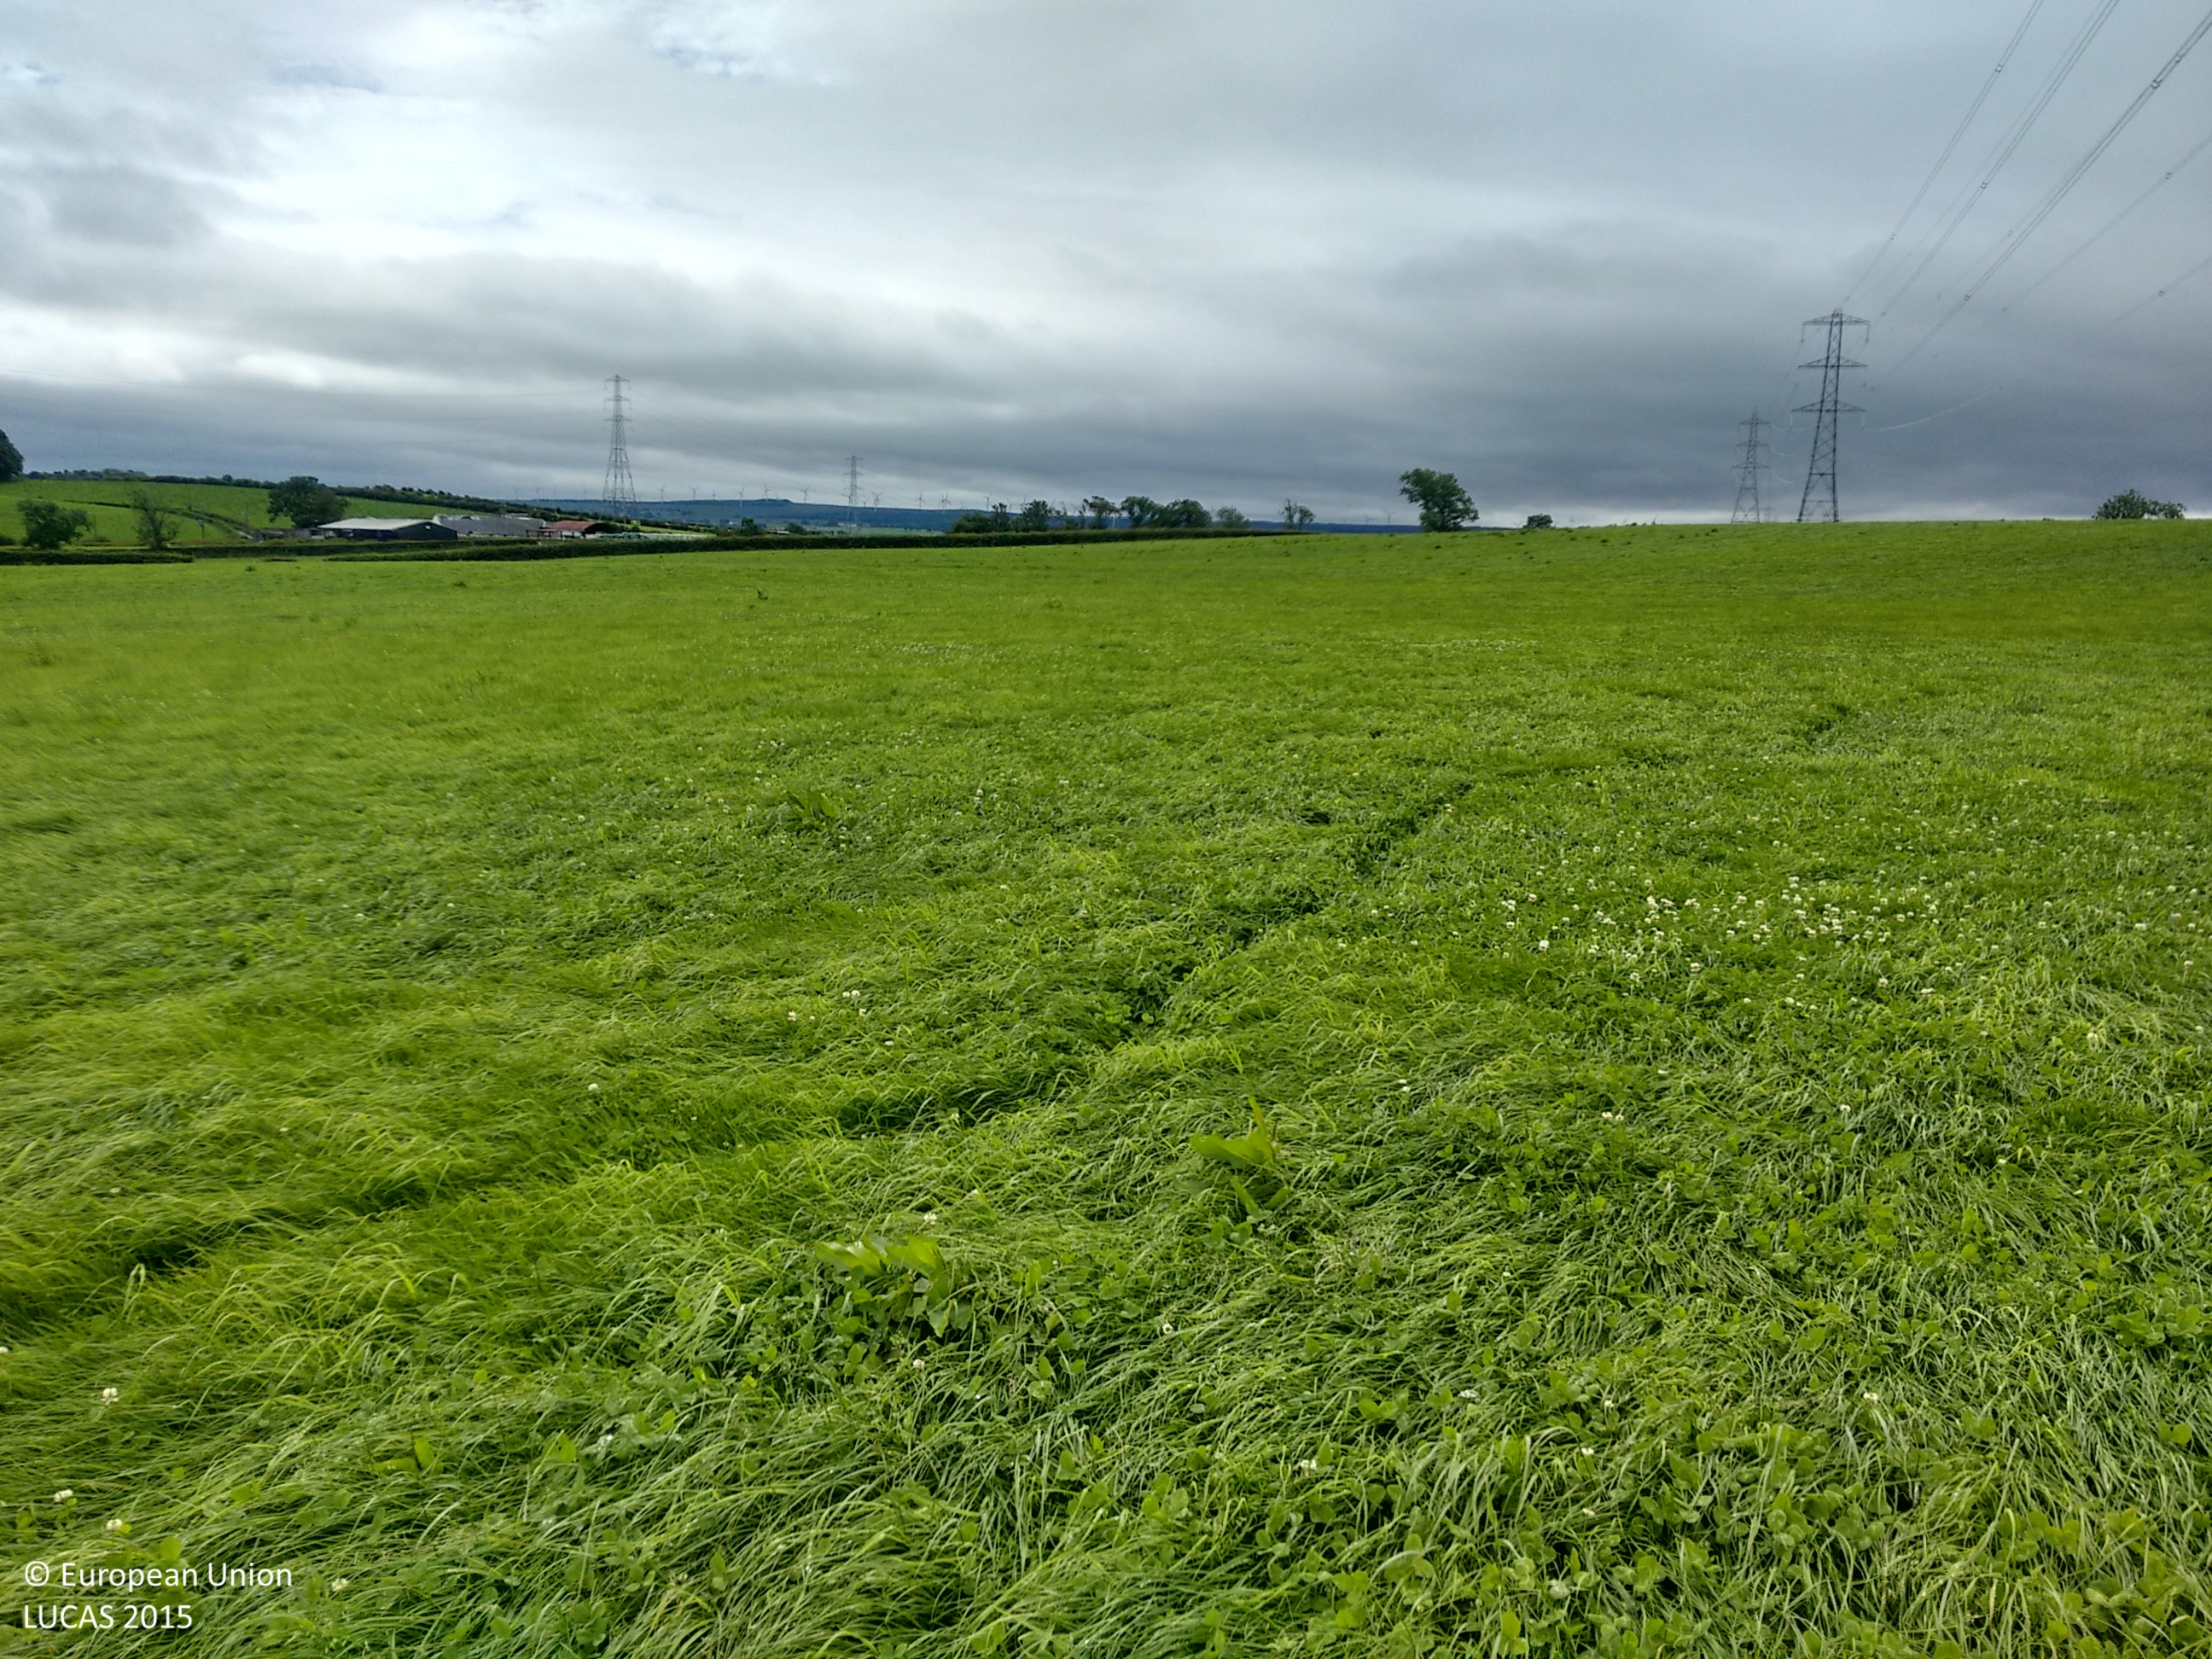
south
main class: Grassland
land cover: Grassland without tree/shrub cover
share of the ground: > 75 %
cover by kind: herbaceous plants 100 %
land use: Agriculture (excluding fallow land and kitchen gardens)
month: July
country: GB
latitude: 55.7692
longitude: -4.2643
